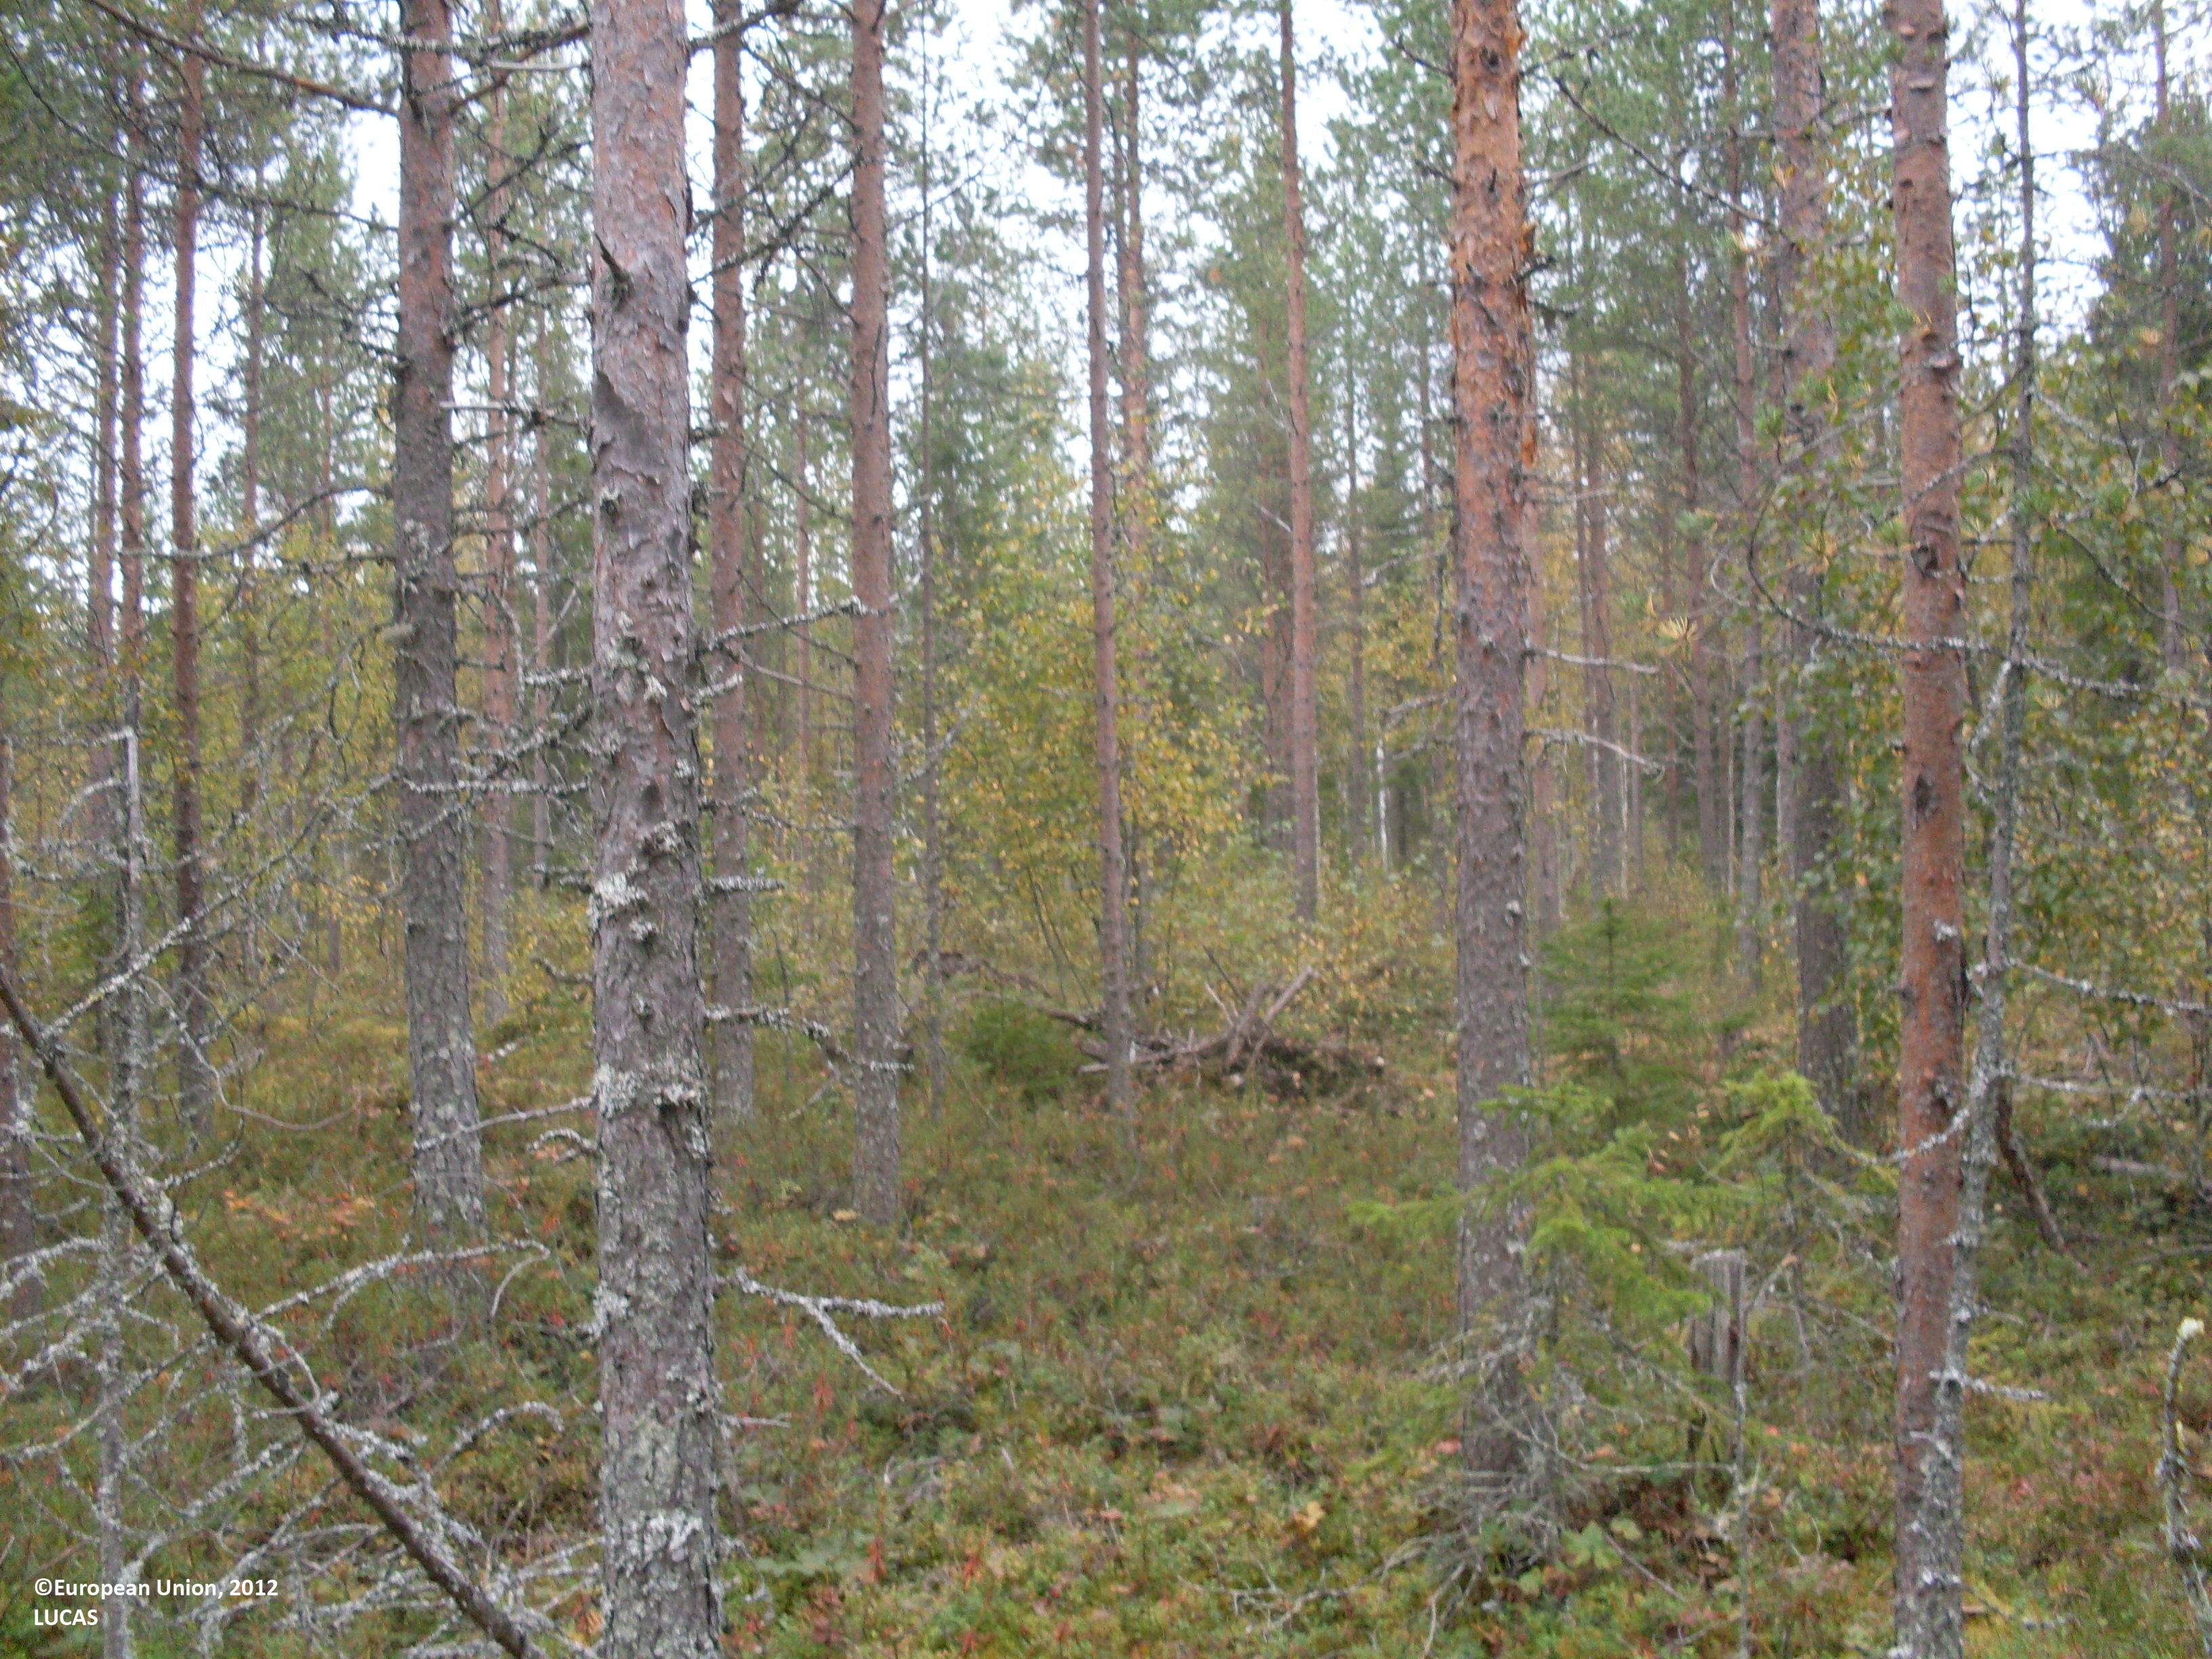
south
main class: Woodland
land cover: Pine dominated coniferous woodland
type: boreal forest
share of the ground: > 75 %
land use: Forestry
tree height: > 5 m
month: September
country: FI
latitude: 64.0416
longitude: 29.7010
